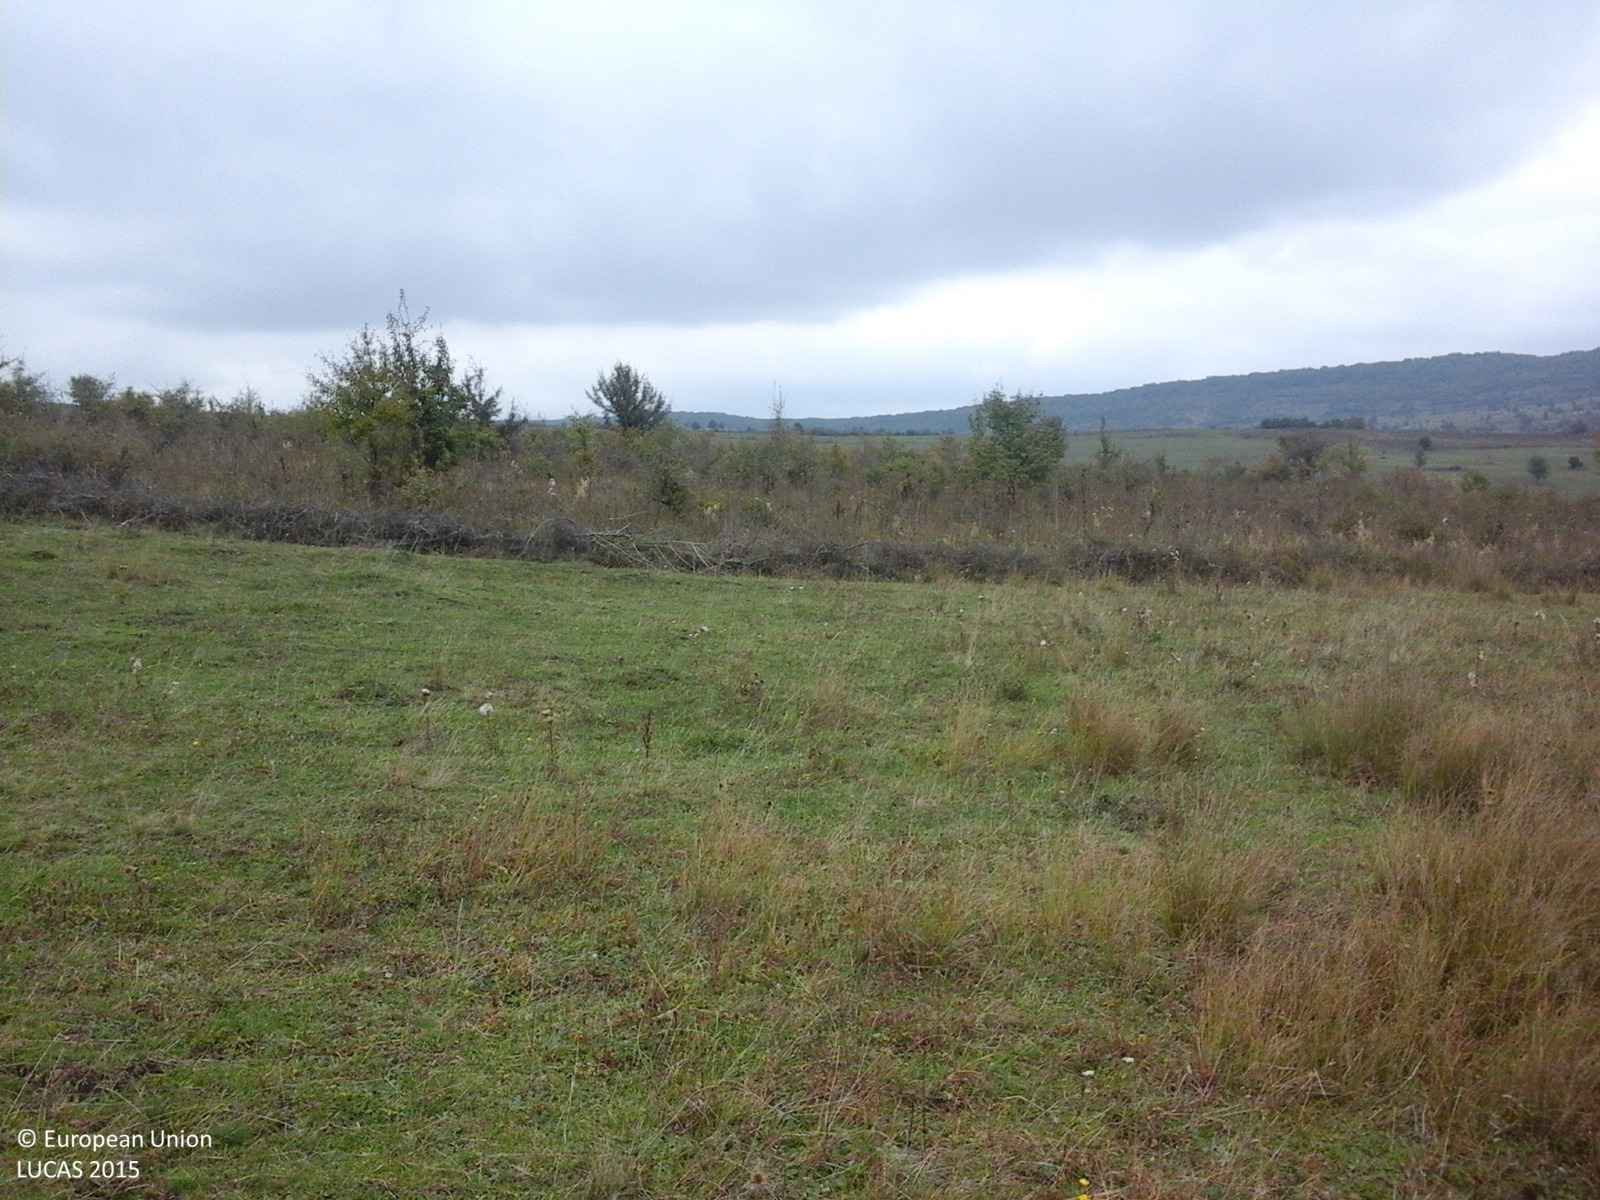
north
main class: Grassland
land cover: Grassland with sparse tree/shrub cover
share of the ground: > 75 %
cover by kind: herbaceous plants 85 %, shrubs 10 %, broadleaved forest trees 5 %
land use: Fallow land
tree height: < 5 m
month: October
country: RO
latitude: 46.0547
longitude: 25.1289
